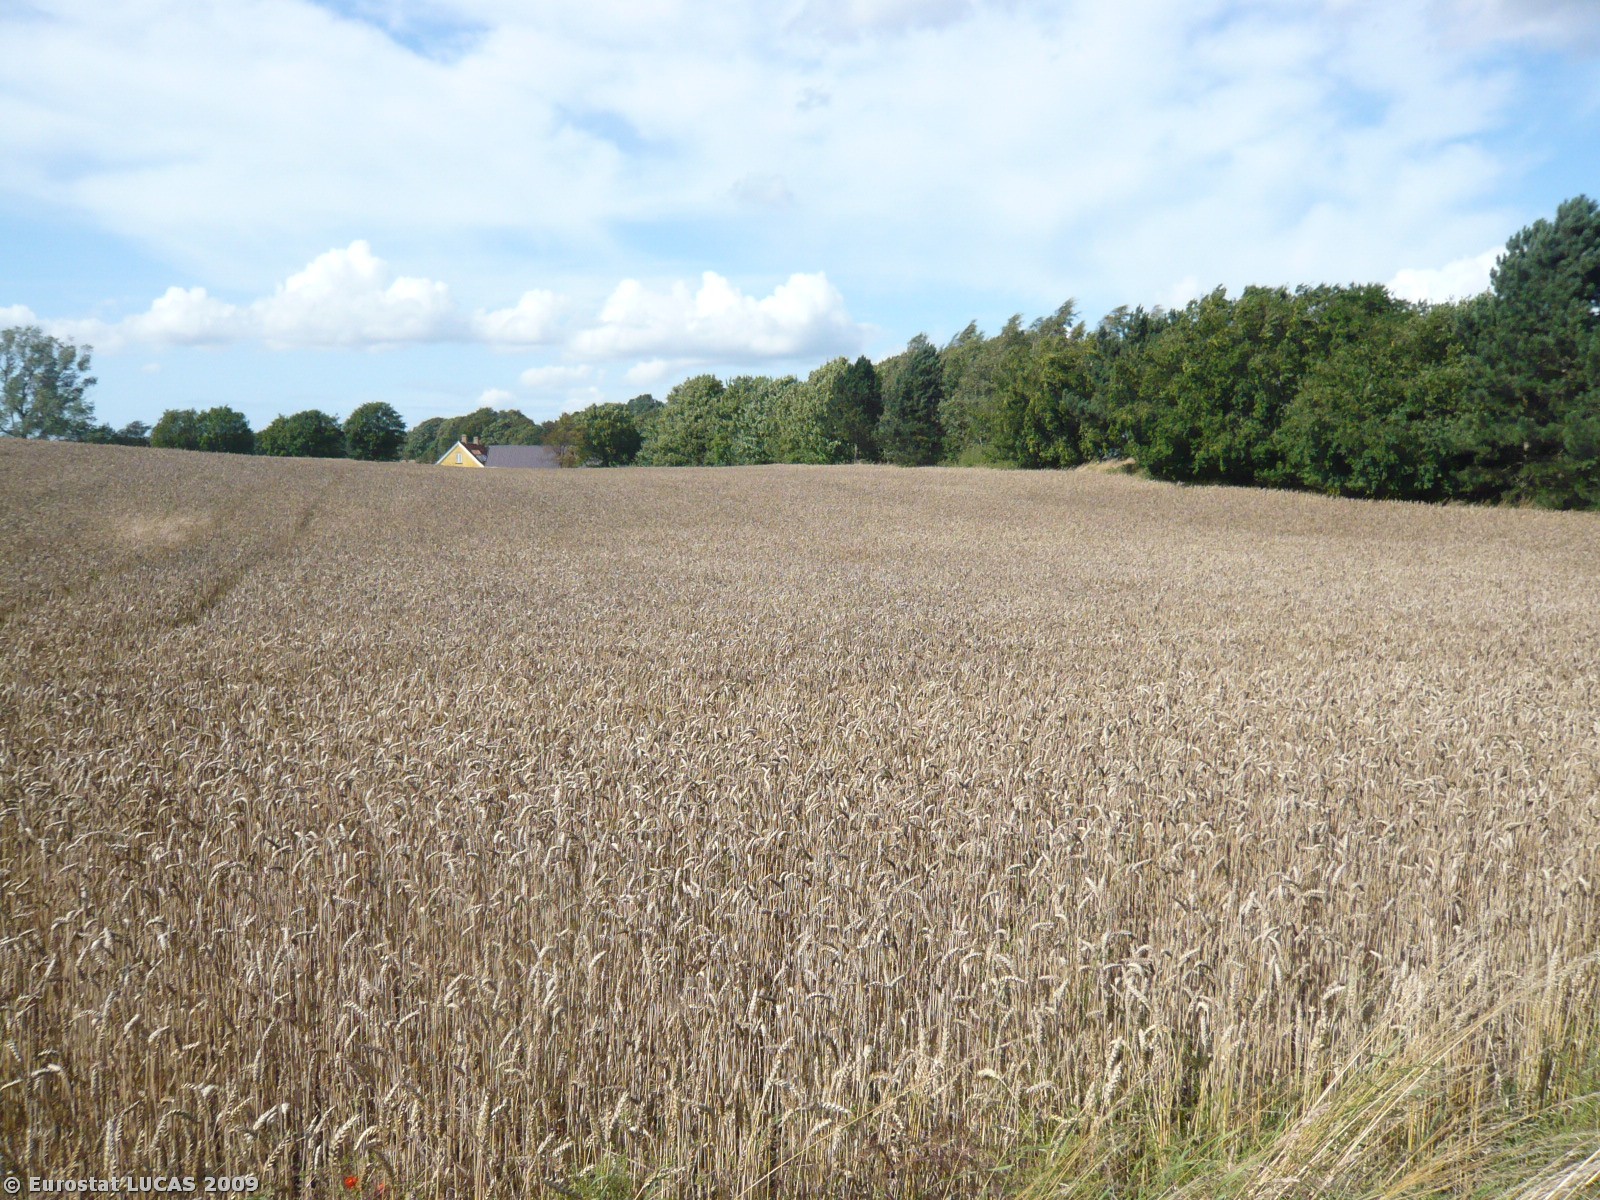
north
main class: Woodland
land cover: Coniferous woodland
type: hemiboreal forest and nemoral coniferous forest and mixed broadleaved-coniferous forest
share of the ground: 50 - 75 %
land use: Forestry
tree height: > 5 m
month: July
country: DK
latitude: 55.8965
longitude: 12.3487
